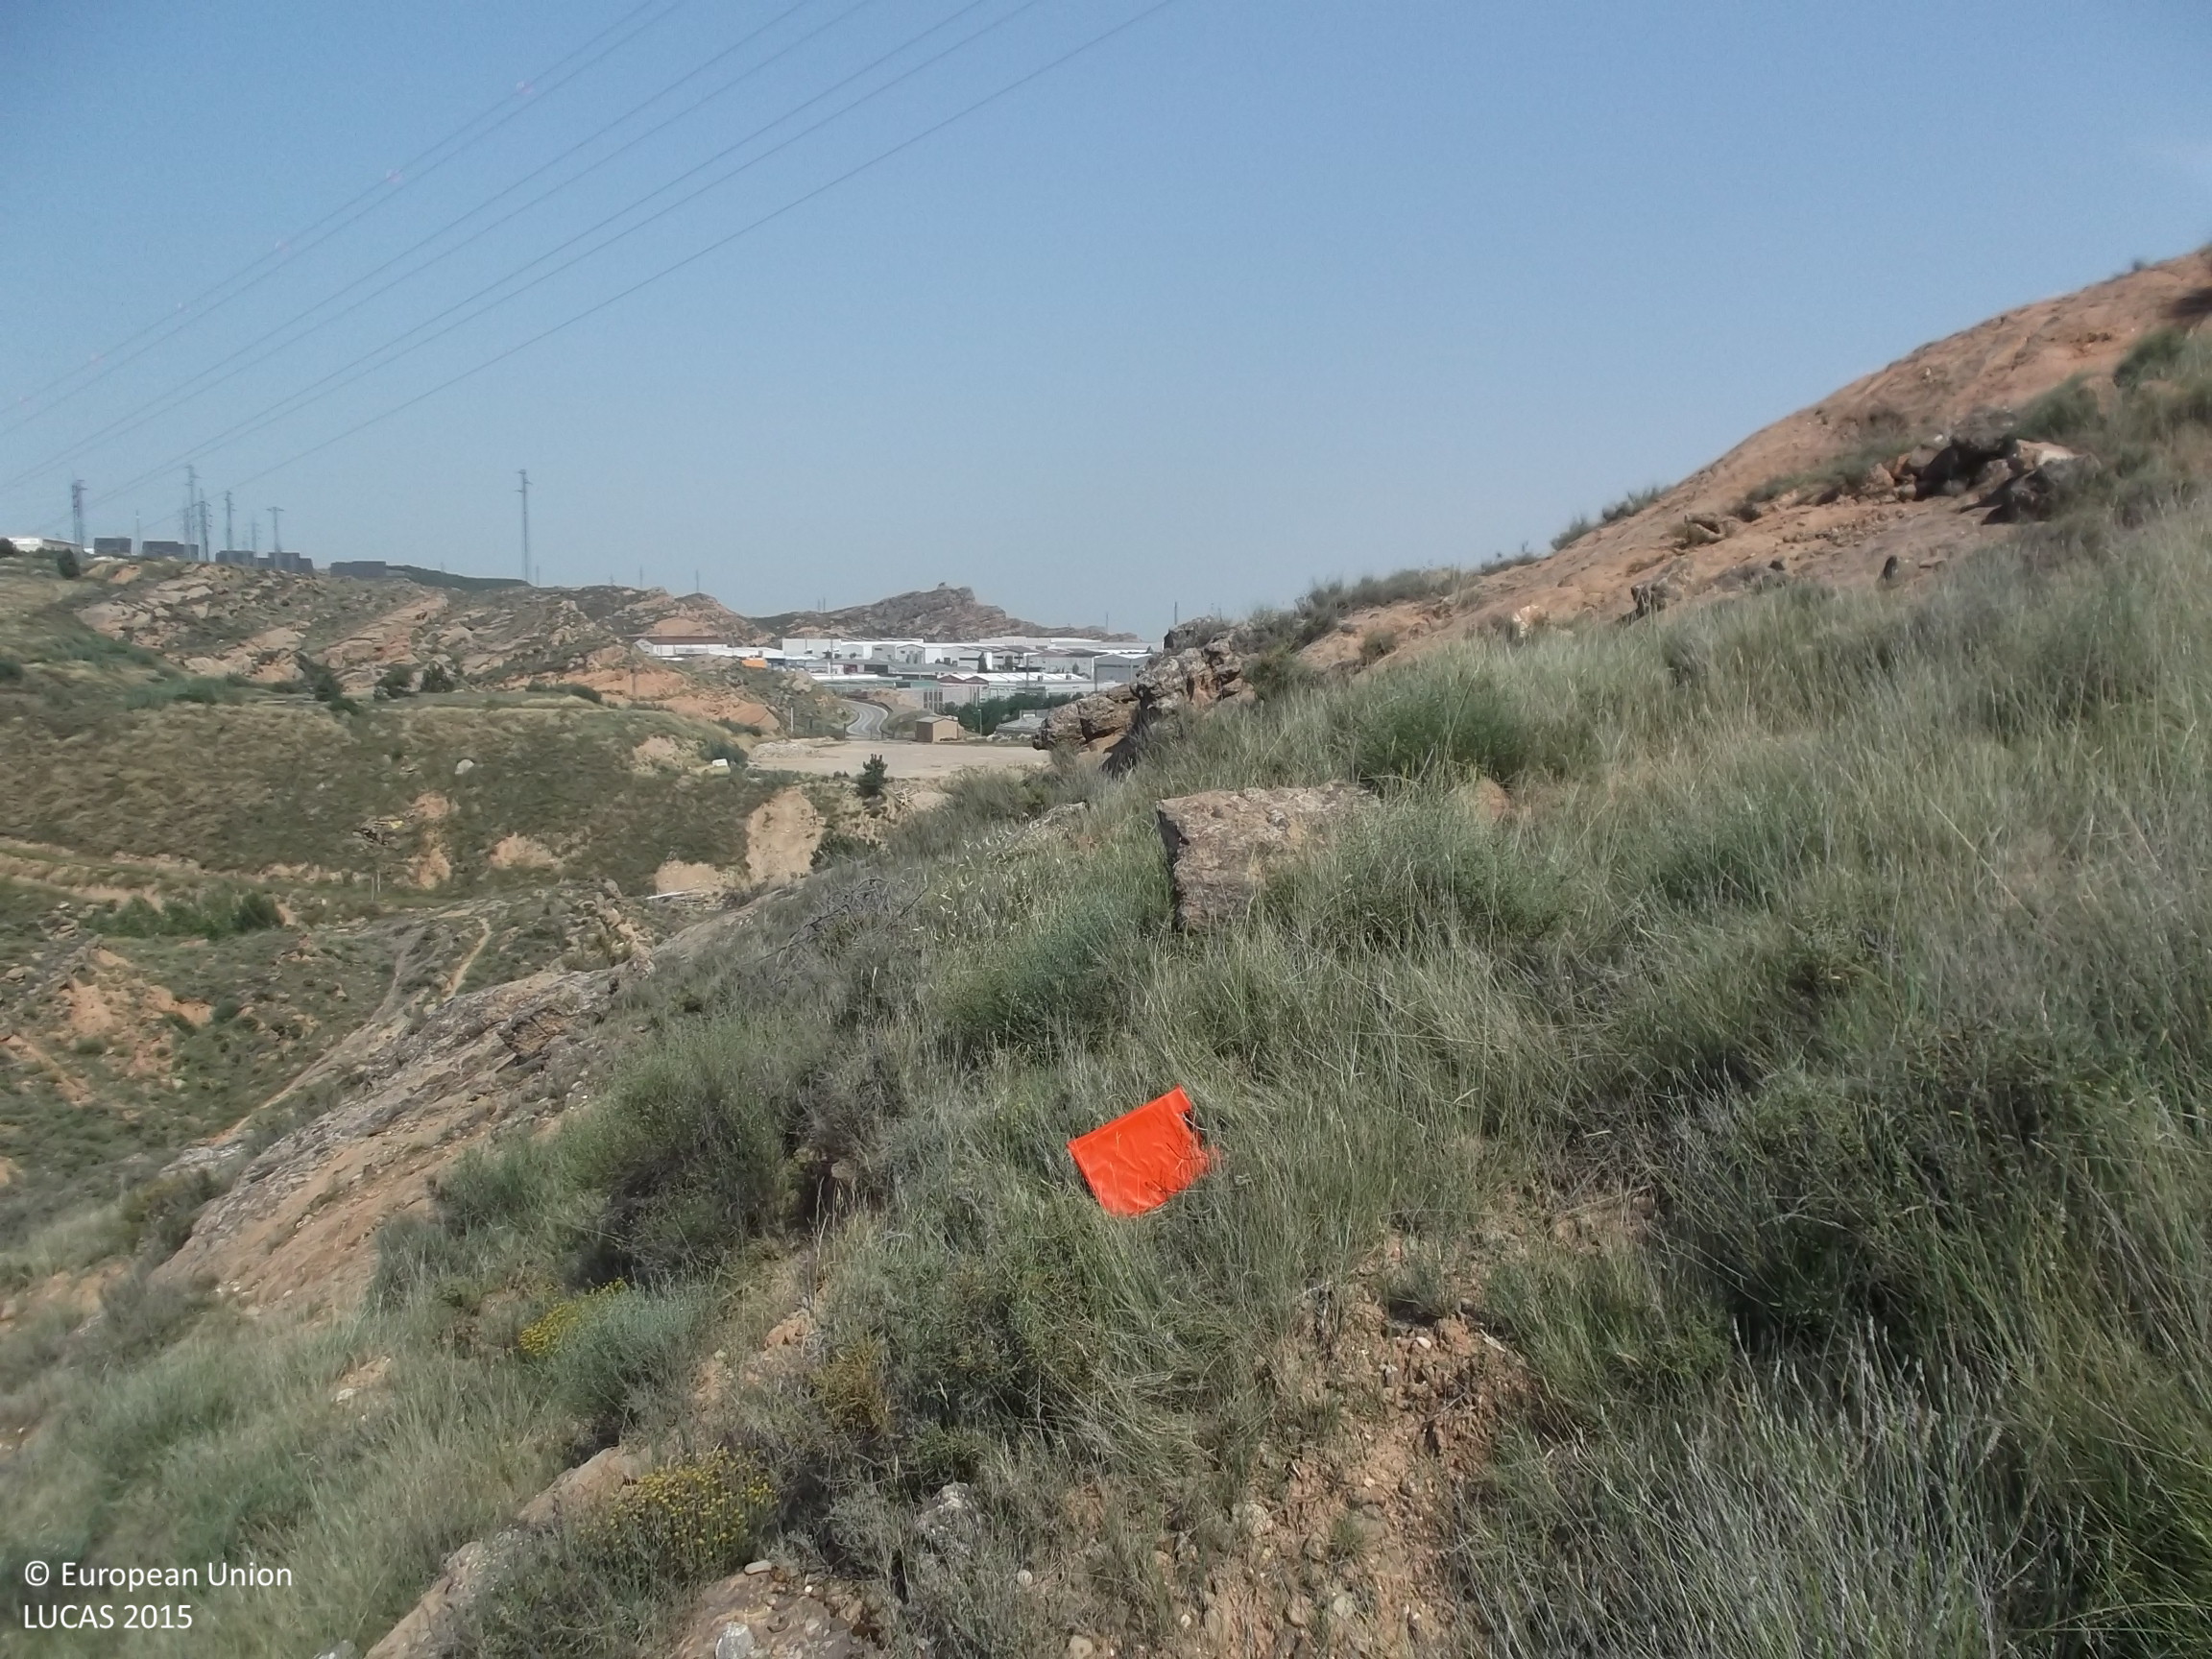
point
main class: Shrubland
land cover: Shrubland without tree cover
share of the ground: 50 - 75 %
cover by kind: shrubs 60 %, herbaceous plants 30 %, unconsolidated bare surface 10 %
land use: Semi-natural and natural areas not in use
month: June
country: ES
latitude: 42.2364
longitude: -2.0957
